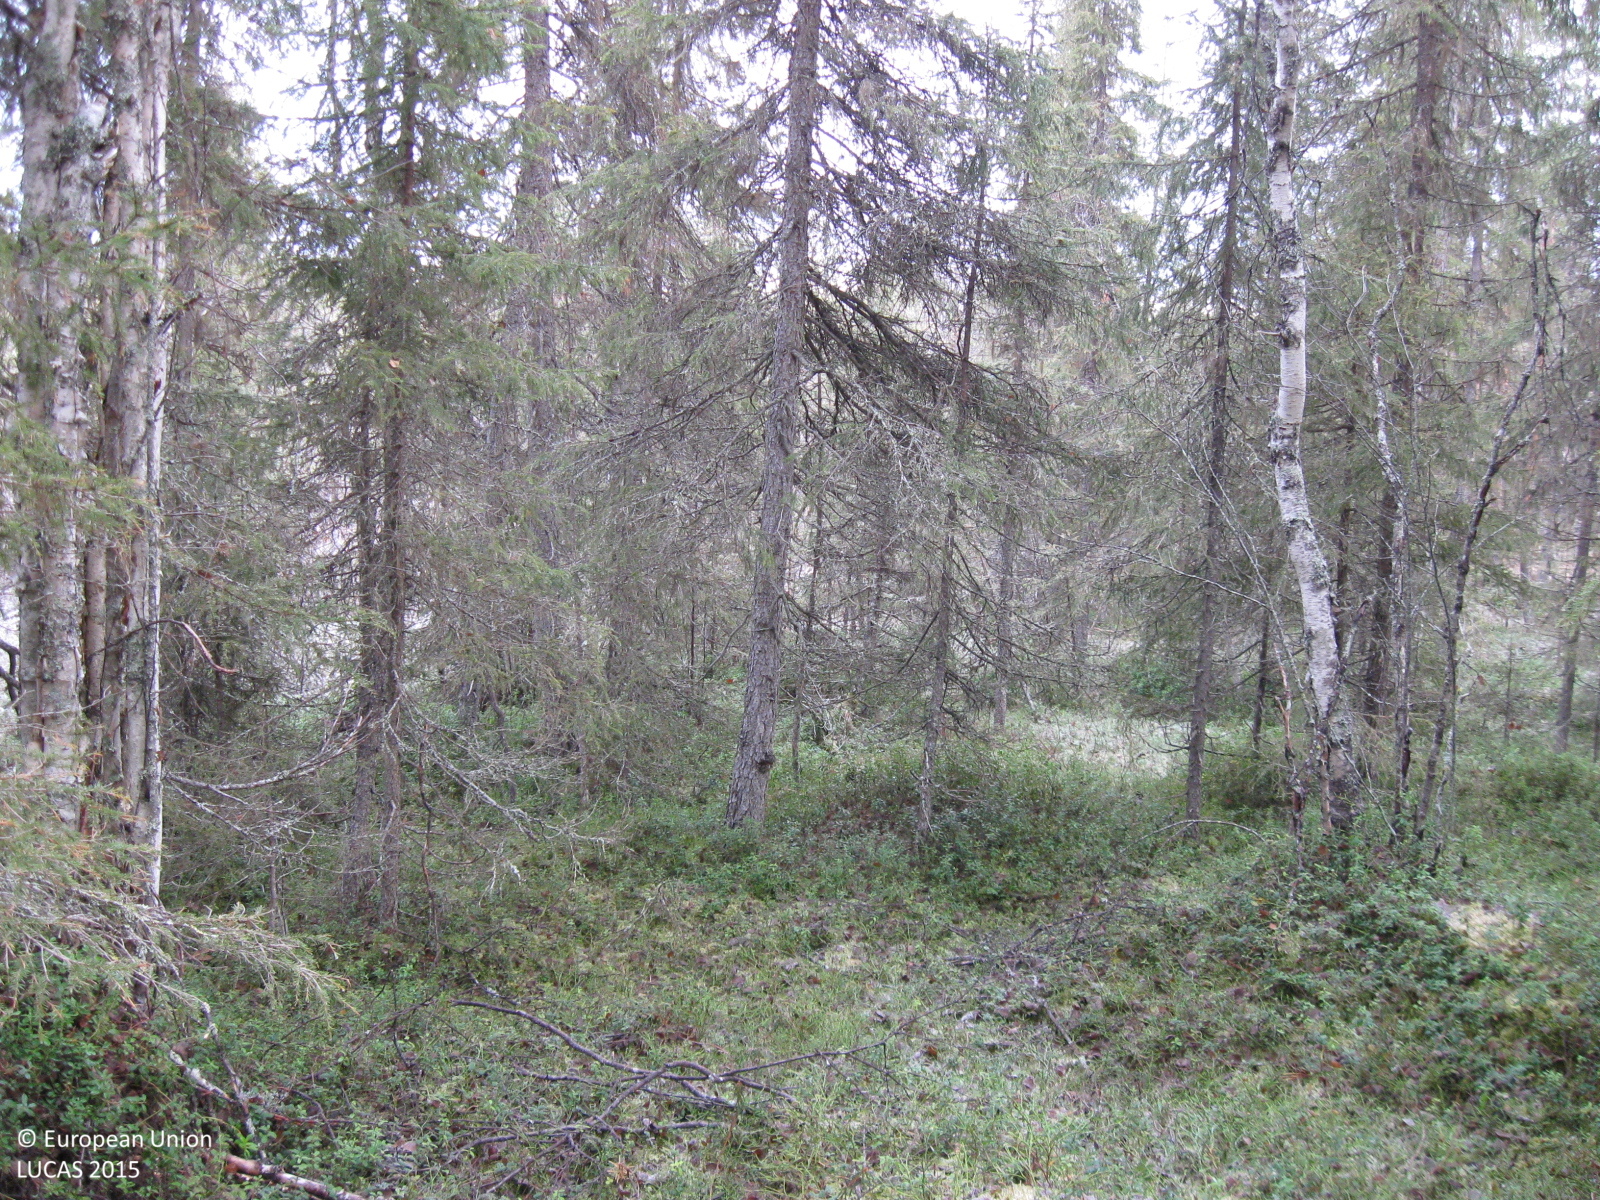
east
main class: Woodland
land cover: Other mixed woodland
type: boreal forest
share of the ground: > 75 %
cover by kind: coniferous forest trees 60 %, broadleaved forest trees 25 %, shrubs 5 %, herbaceous plants 5 %, lichens and mosses 5 %
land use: Forestry
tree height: > 5 m
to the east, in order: Other mixed woodland; Other coniferous woodland; Peatbogs; Other mixed woodland; Spontaneously vegetated surfaces; Other mixed woodland
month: October
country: SE
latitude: 66.2481
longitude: 21.5132
